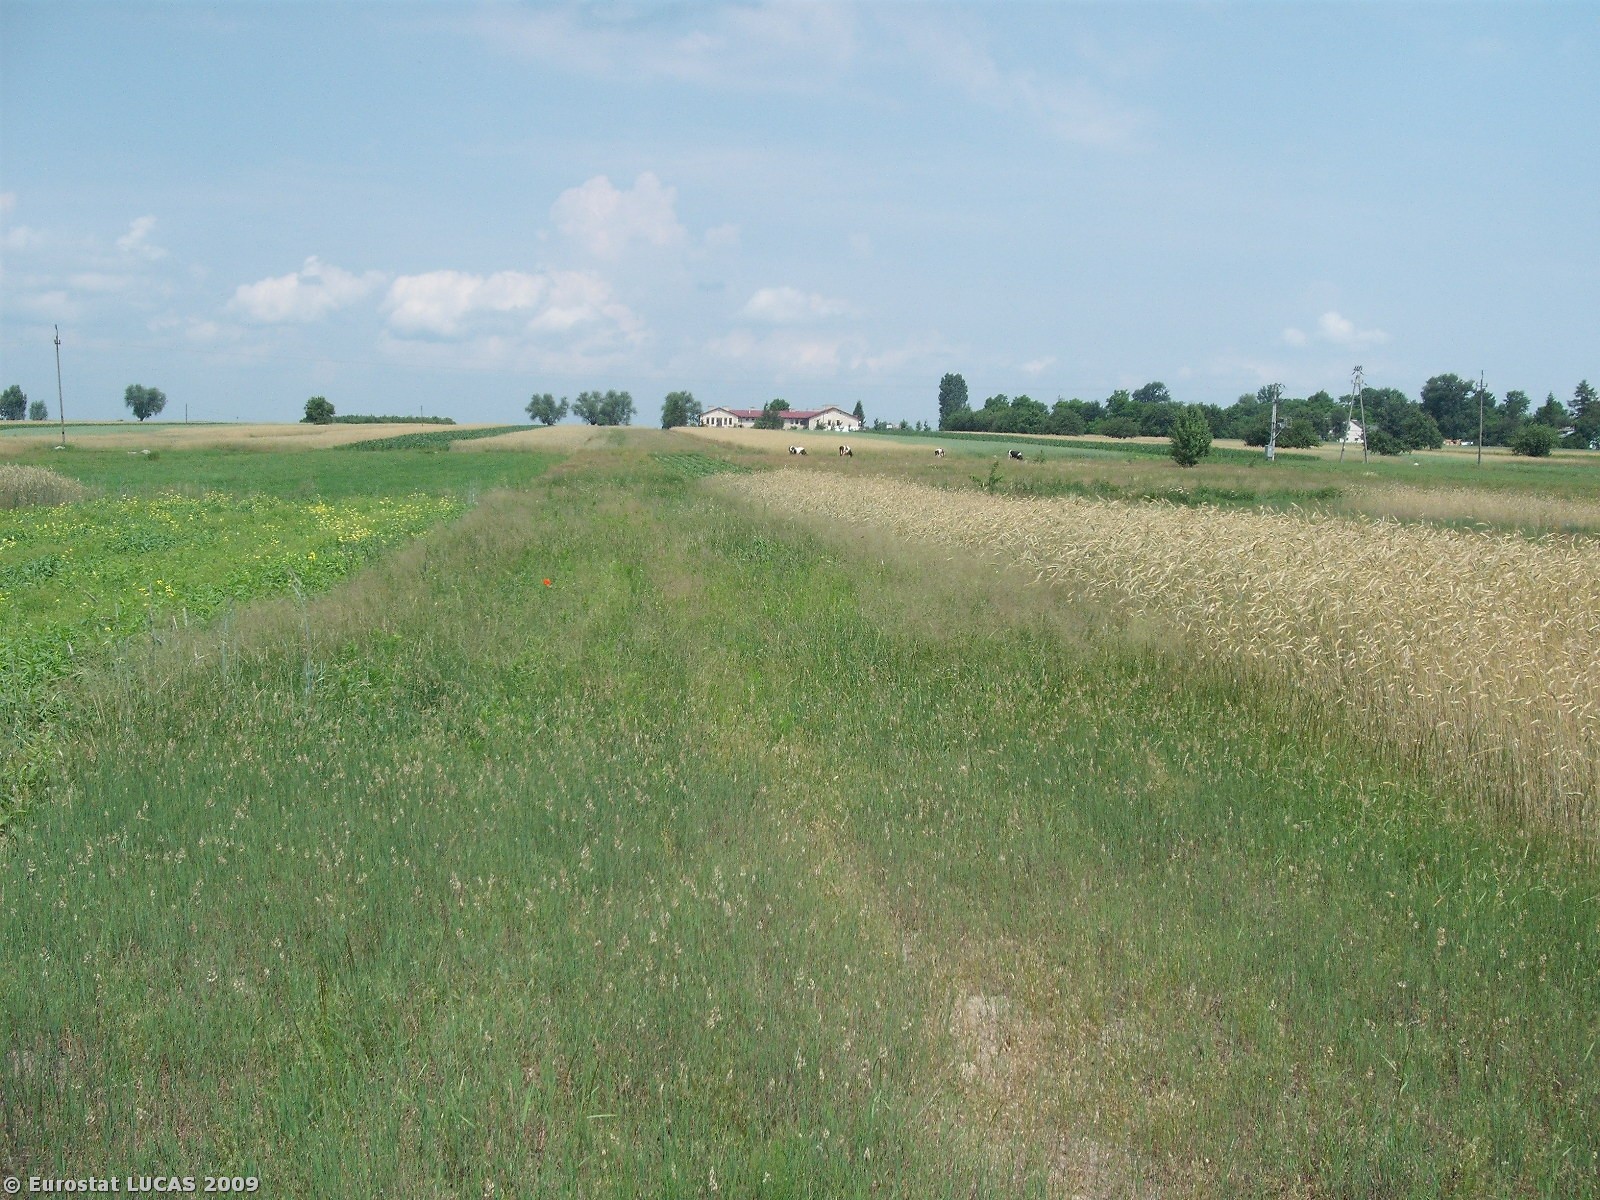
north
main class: Grassland
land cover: Spontaneously vegetated surfaces
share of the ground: > 75 %
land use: Fallow land
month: July
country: PL
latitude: 51.4492
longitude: 20.5869
